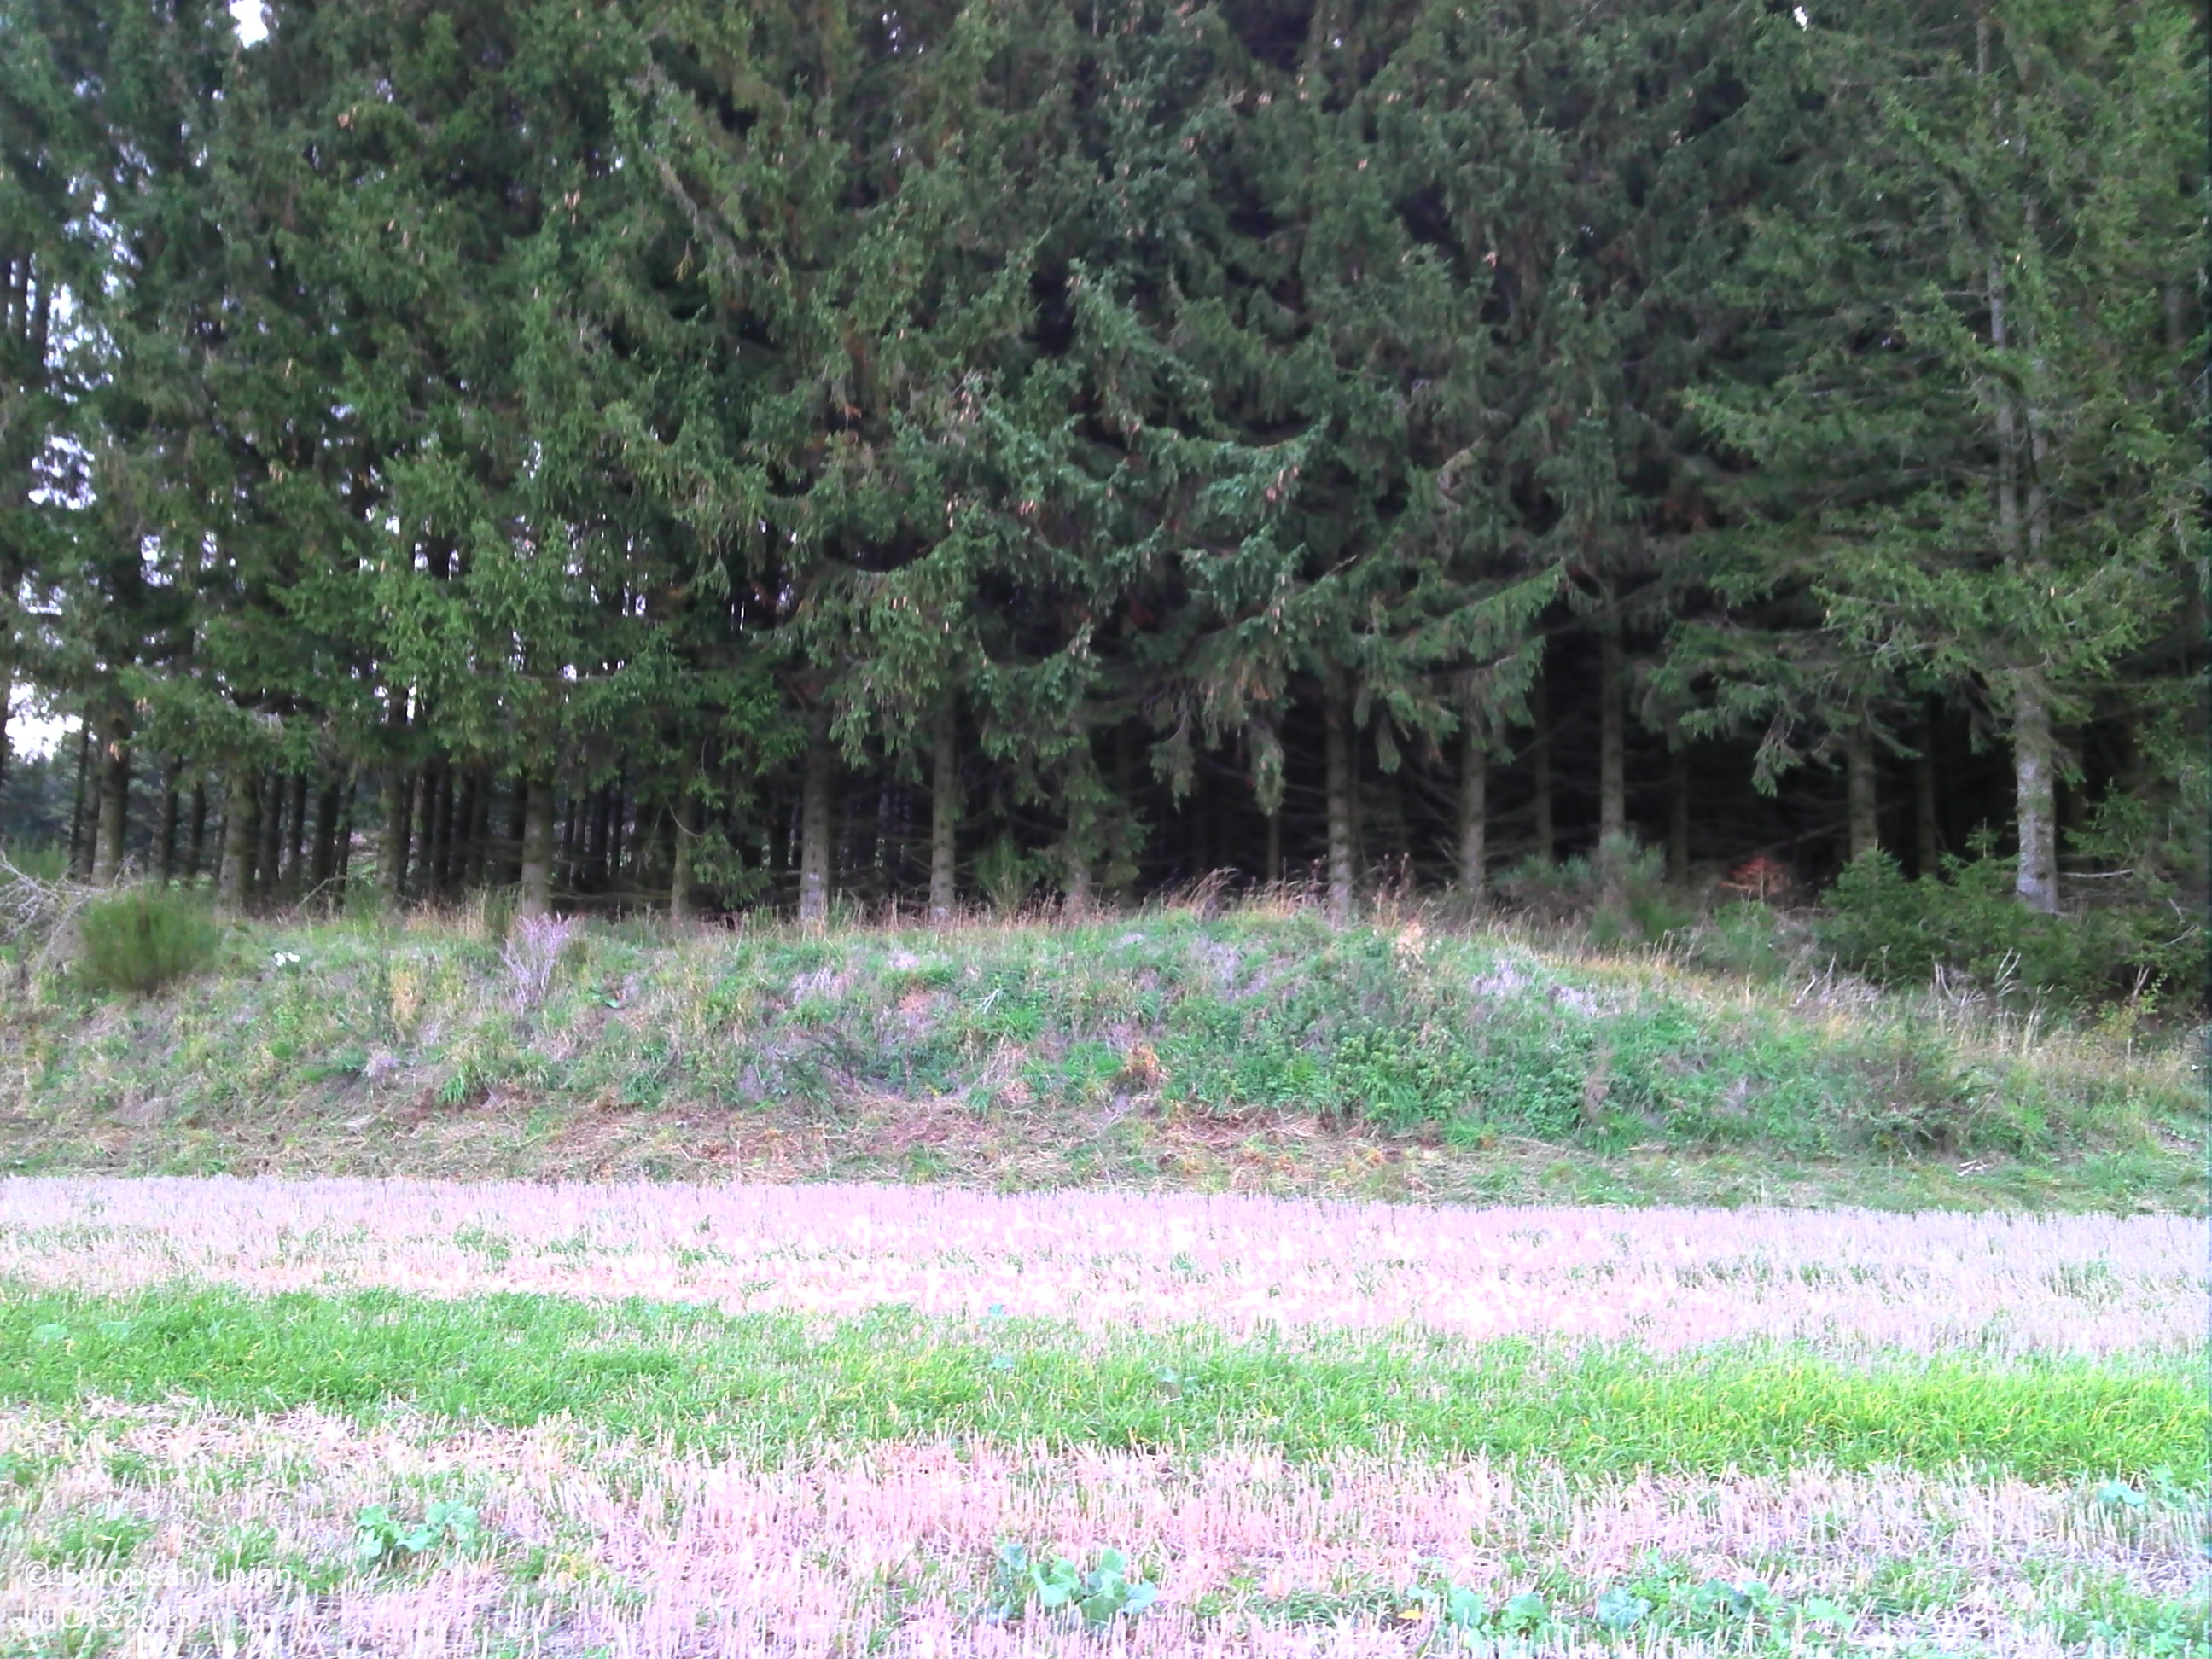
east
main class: Cropland
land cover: Common wheat
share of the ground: 50 - 75 %
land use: Agriculture (excluding fallow land and kitchen gardens)
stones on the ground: < 10 %
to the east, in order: Common wheat; Grassland without tree/shrub cover; Spruce dominated coniferous woodland; Dry stone walls; Other coniferous woodland; Other mixed woodland; Other coniferous woodland
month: October
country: FR
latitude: 44.8368
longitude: 3.8442
